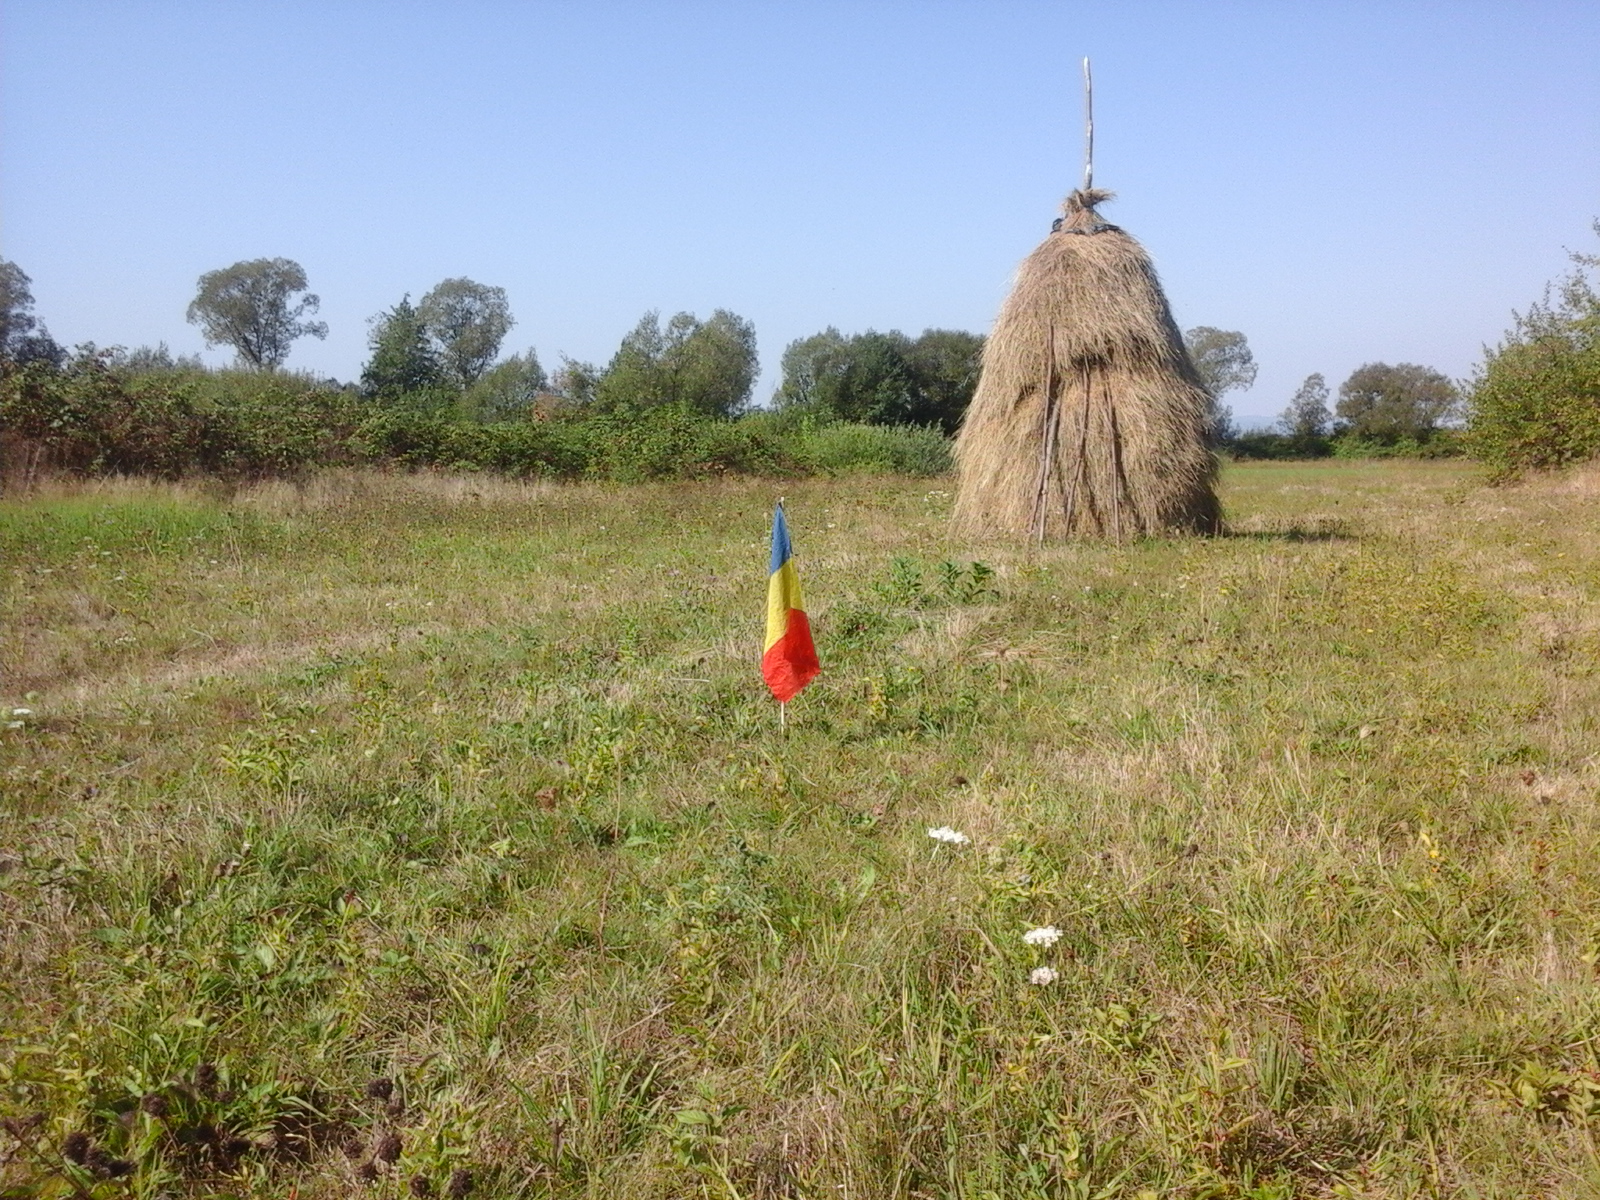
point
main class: Grassland
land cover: Grassland without tree/shrub cover
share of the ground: > 75 %
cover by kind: herbaceous plants 100 %
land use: Agriculture (excluding fallow land and kitchen gardens)
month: September
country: RO
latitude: 46.5961
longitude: 22.5181
